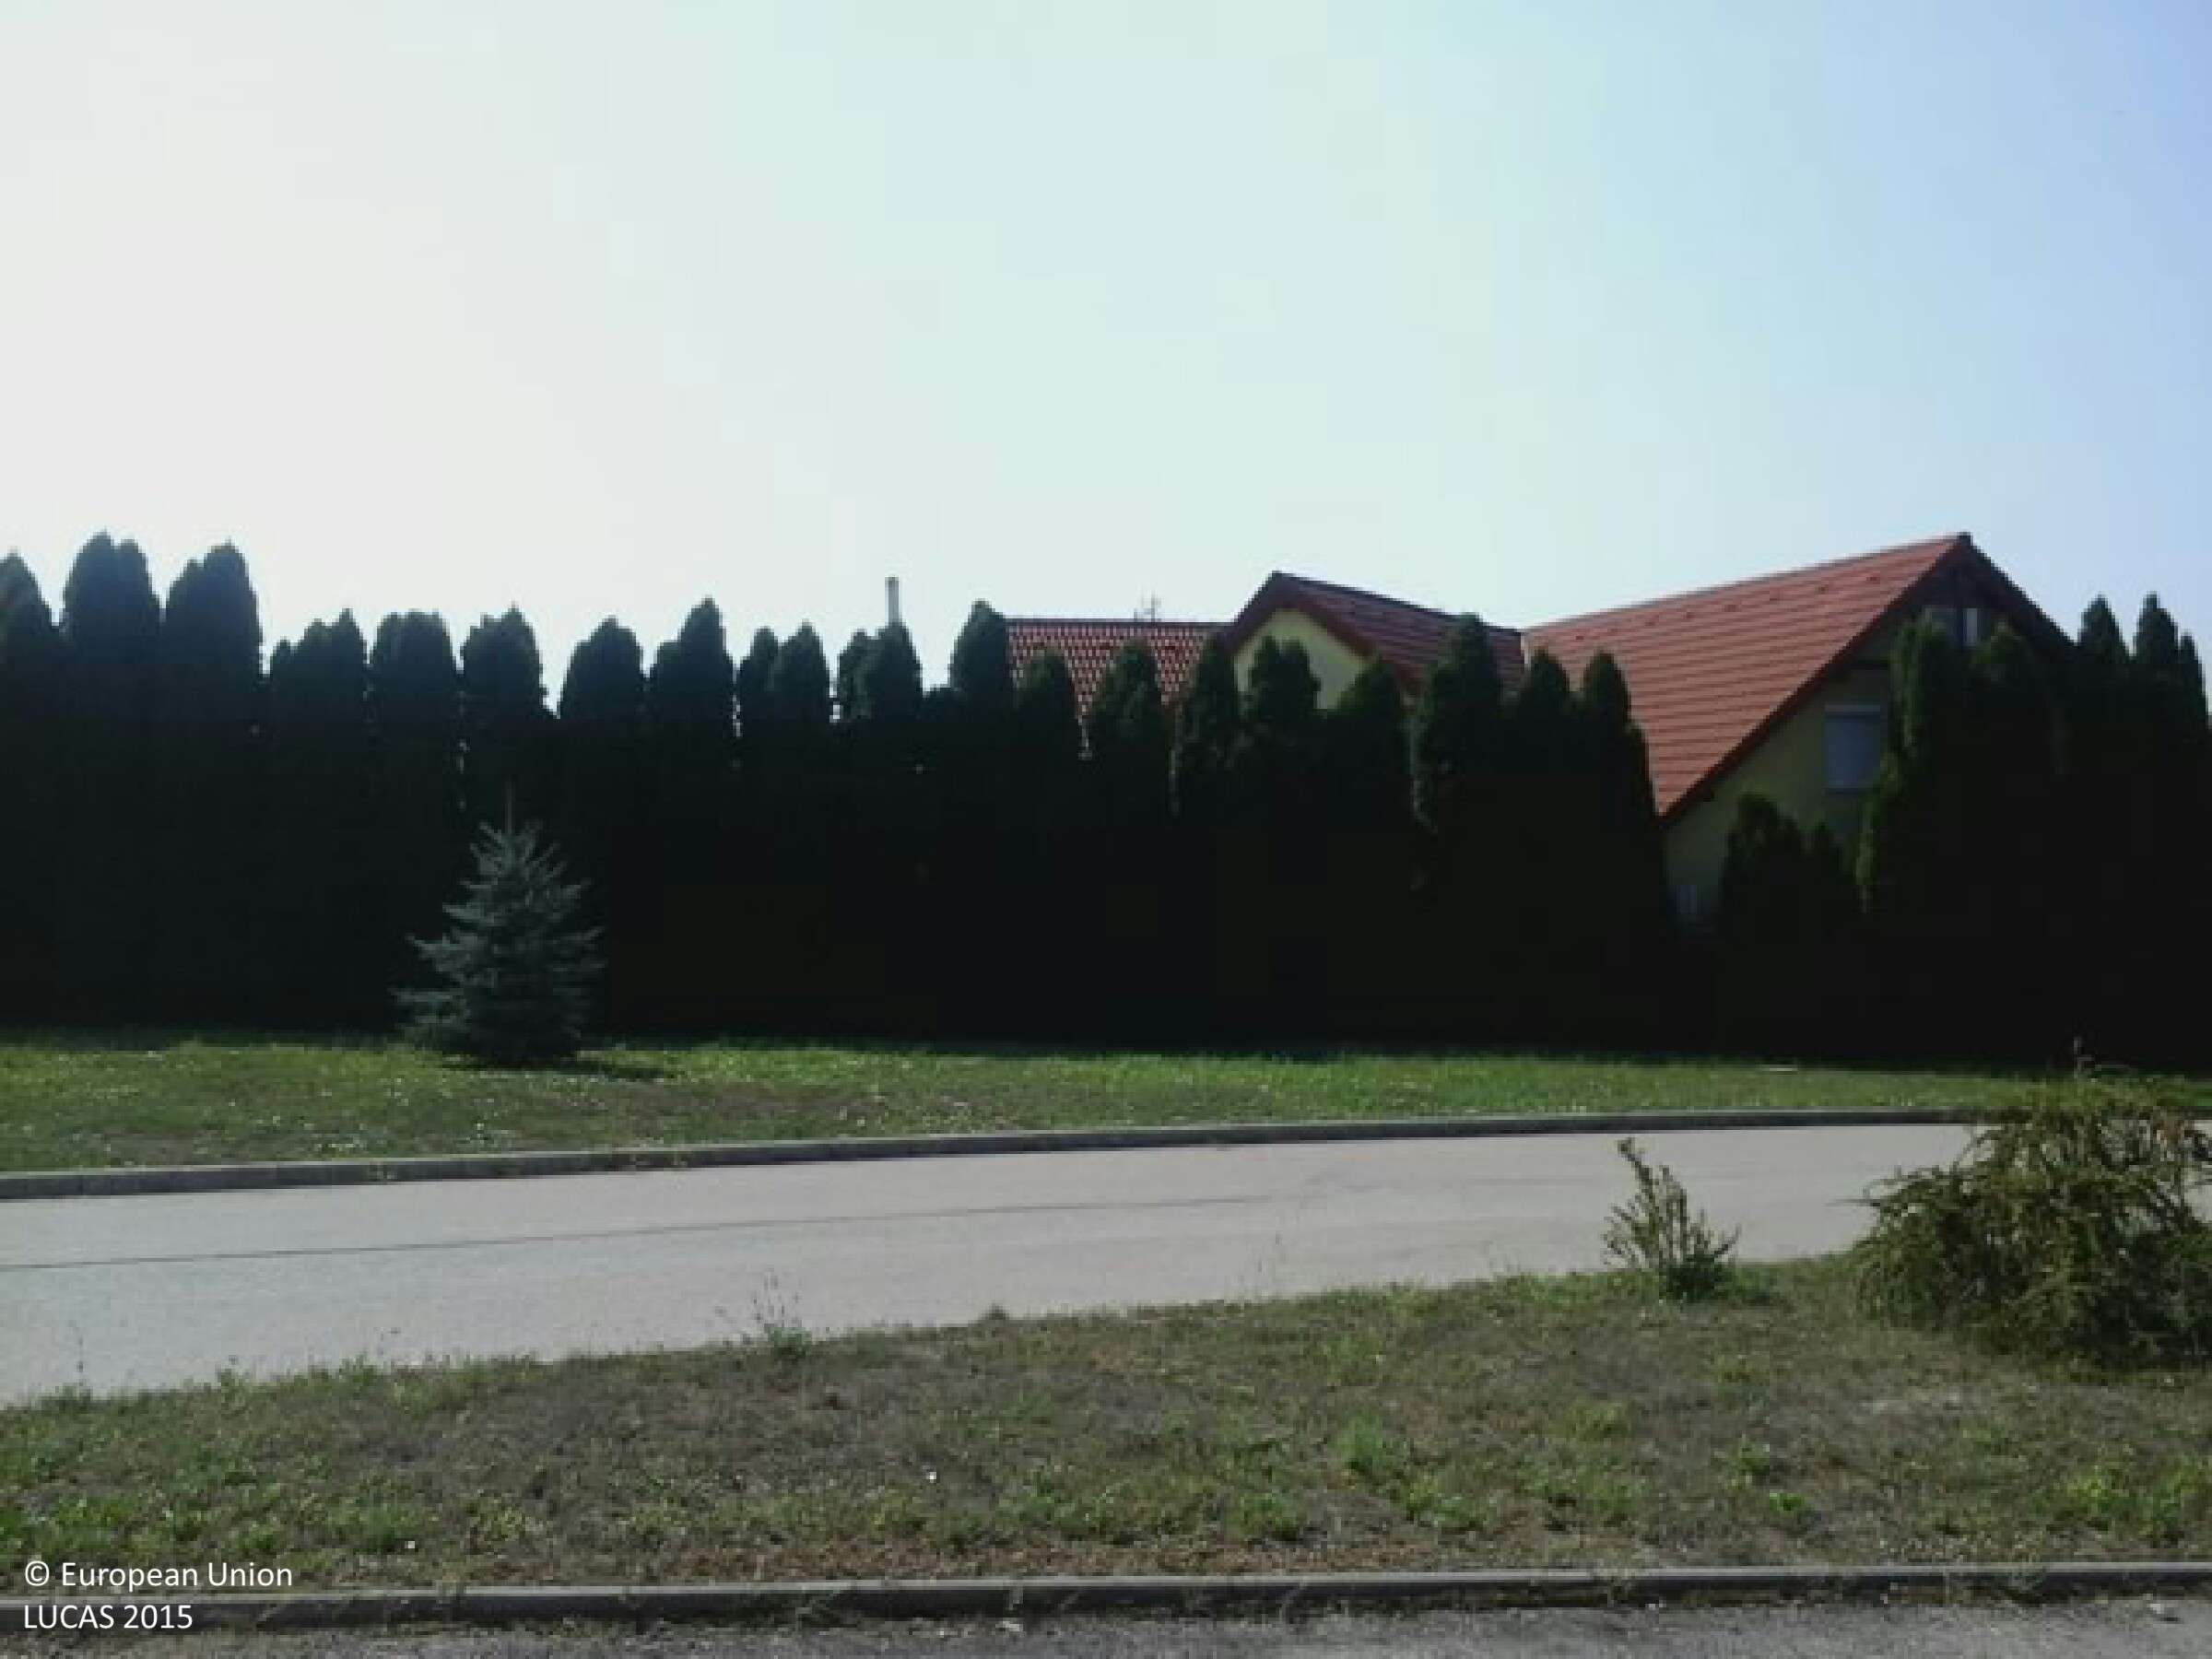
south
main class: Grassland
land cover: Grassland with sparse tree/shrub cover
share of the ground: > 75 %
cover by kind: herbaceous plants 85 %, shrubs 10 %, broadleaved forest trees 5 %
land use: Residential
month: August
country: HU
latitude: 46.9011
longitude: 18.9279
